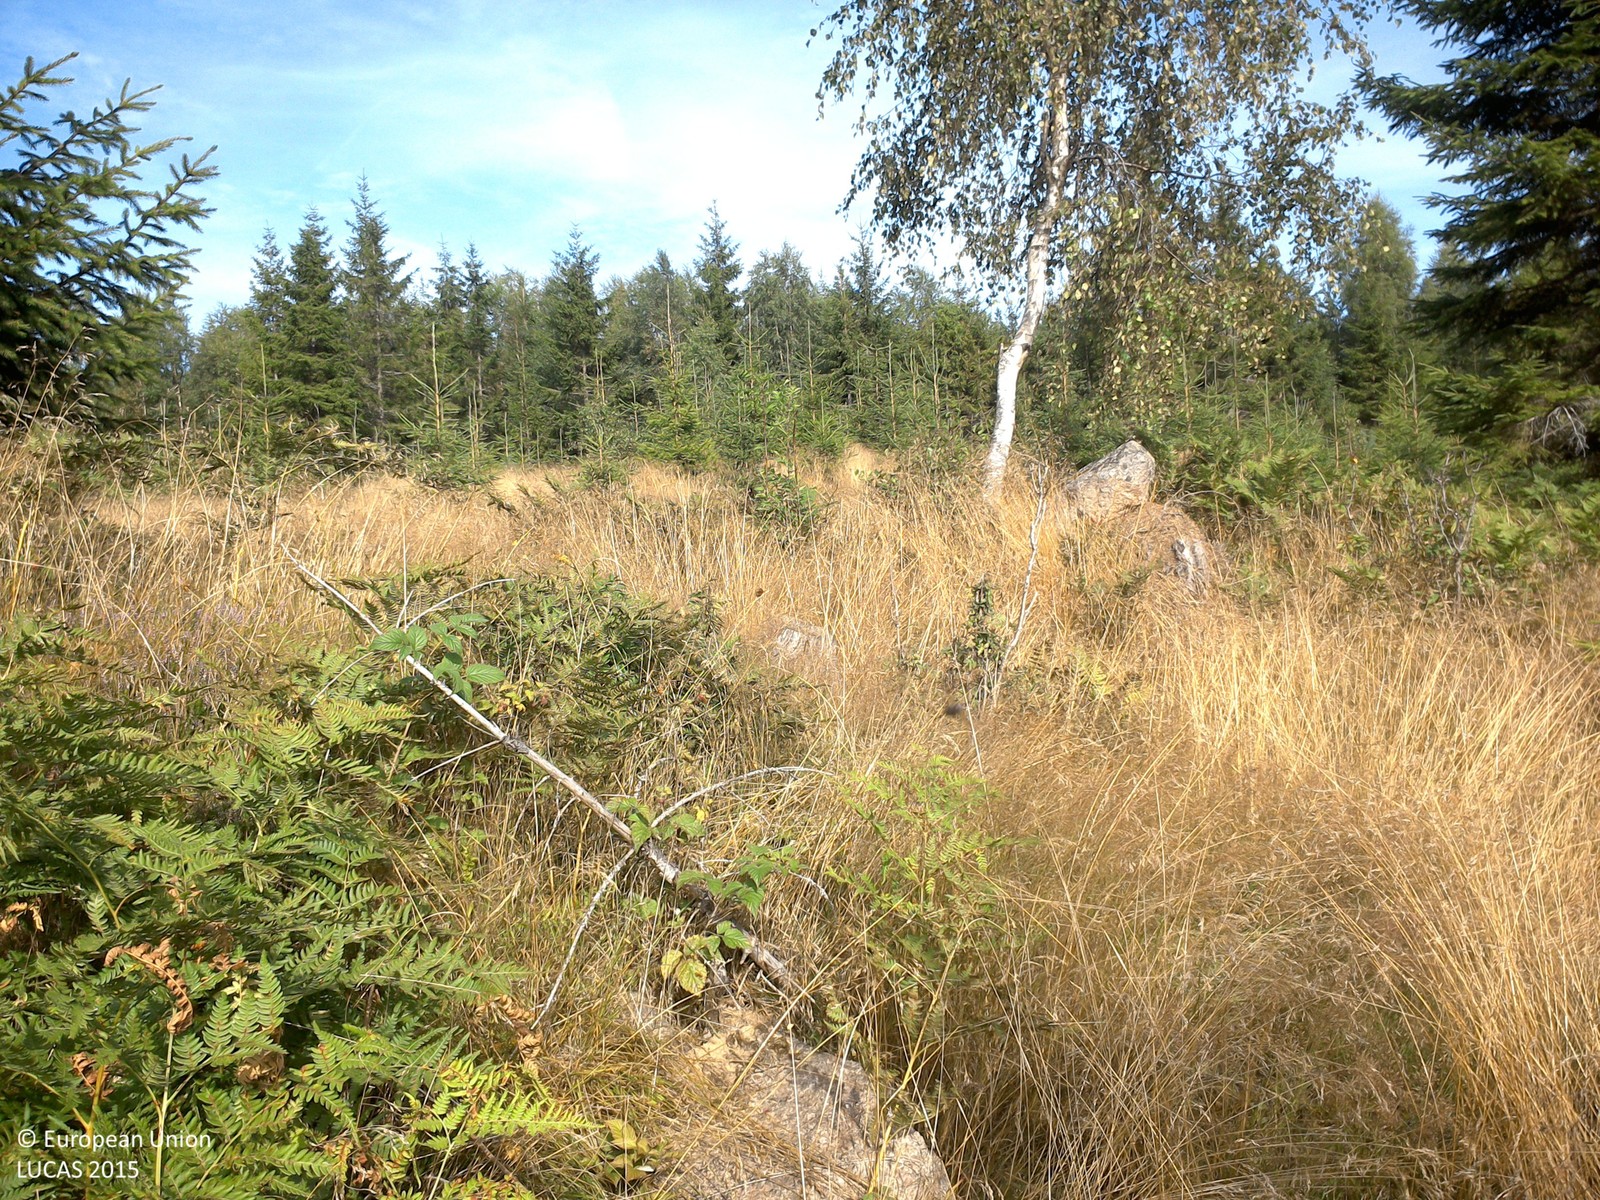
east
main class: Woodland
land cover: Spruce dominated mixed woodland
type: boreal forest
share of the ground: 25 - 50 %
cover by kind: herbaceous plants 70 %, coniferous forest trees 20 %, broadleaved forest trees 10 %
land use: Forestry
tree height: < 5 m
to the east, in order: Spruce dominated mixed woodland; Paved roads, cycling and walking lanes; Spruce dominated coniferous woodland; Tracks; Spruce dominated coniferous woodland; Pine dominated coniferous woodland
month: August
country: SE
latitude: 57.8664
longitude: 15.2041
